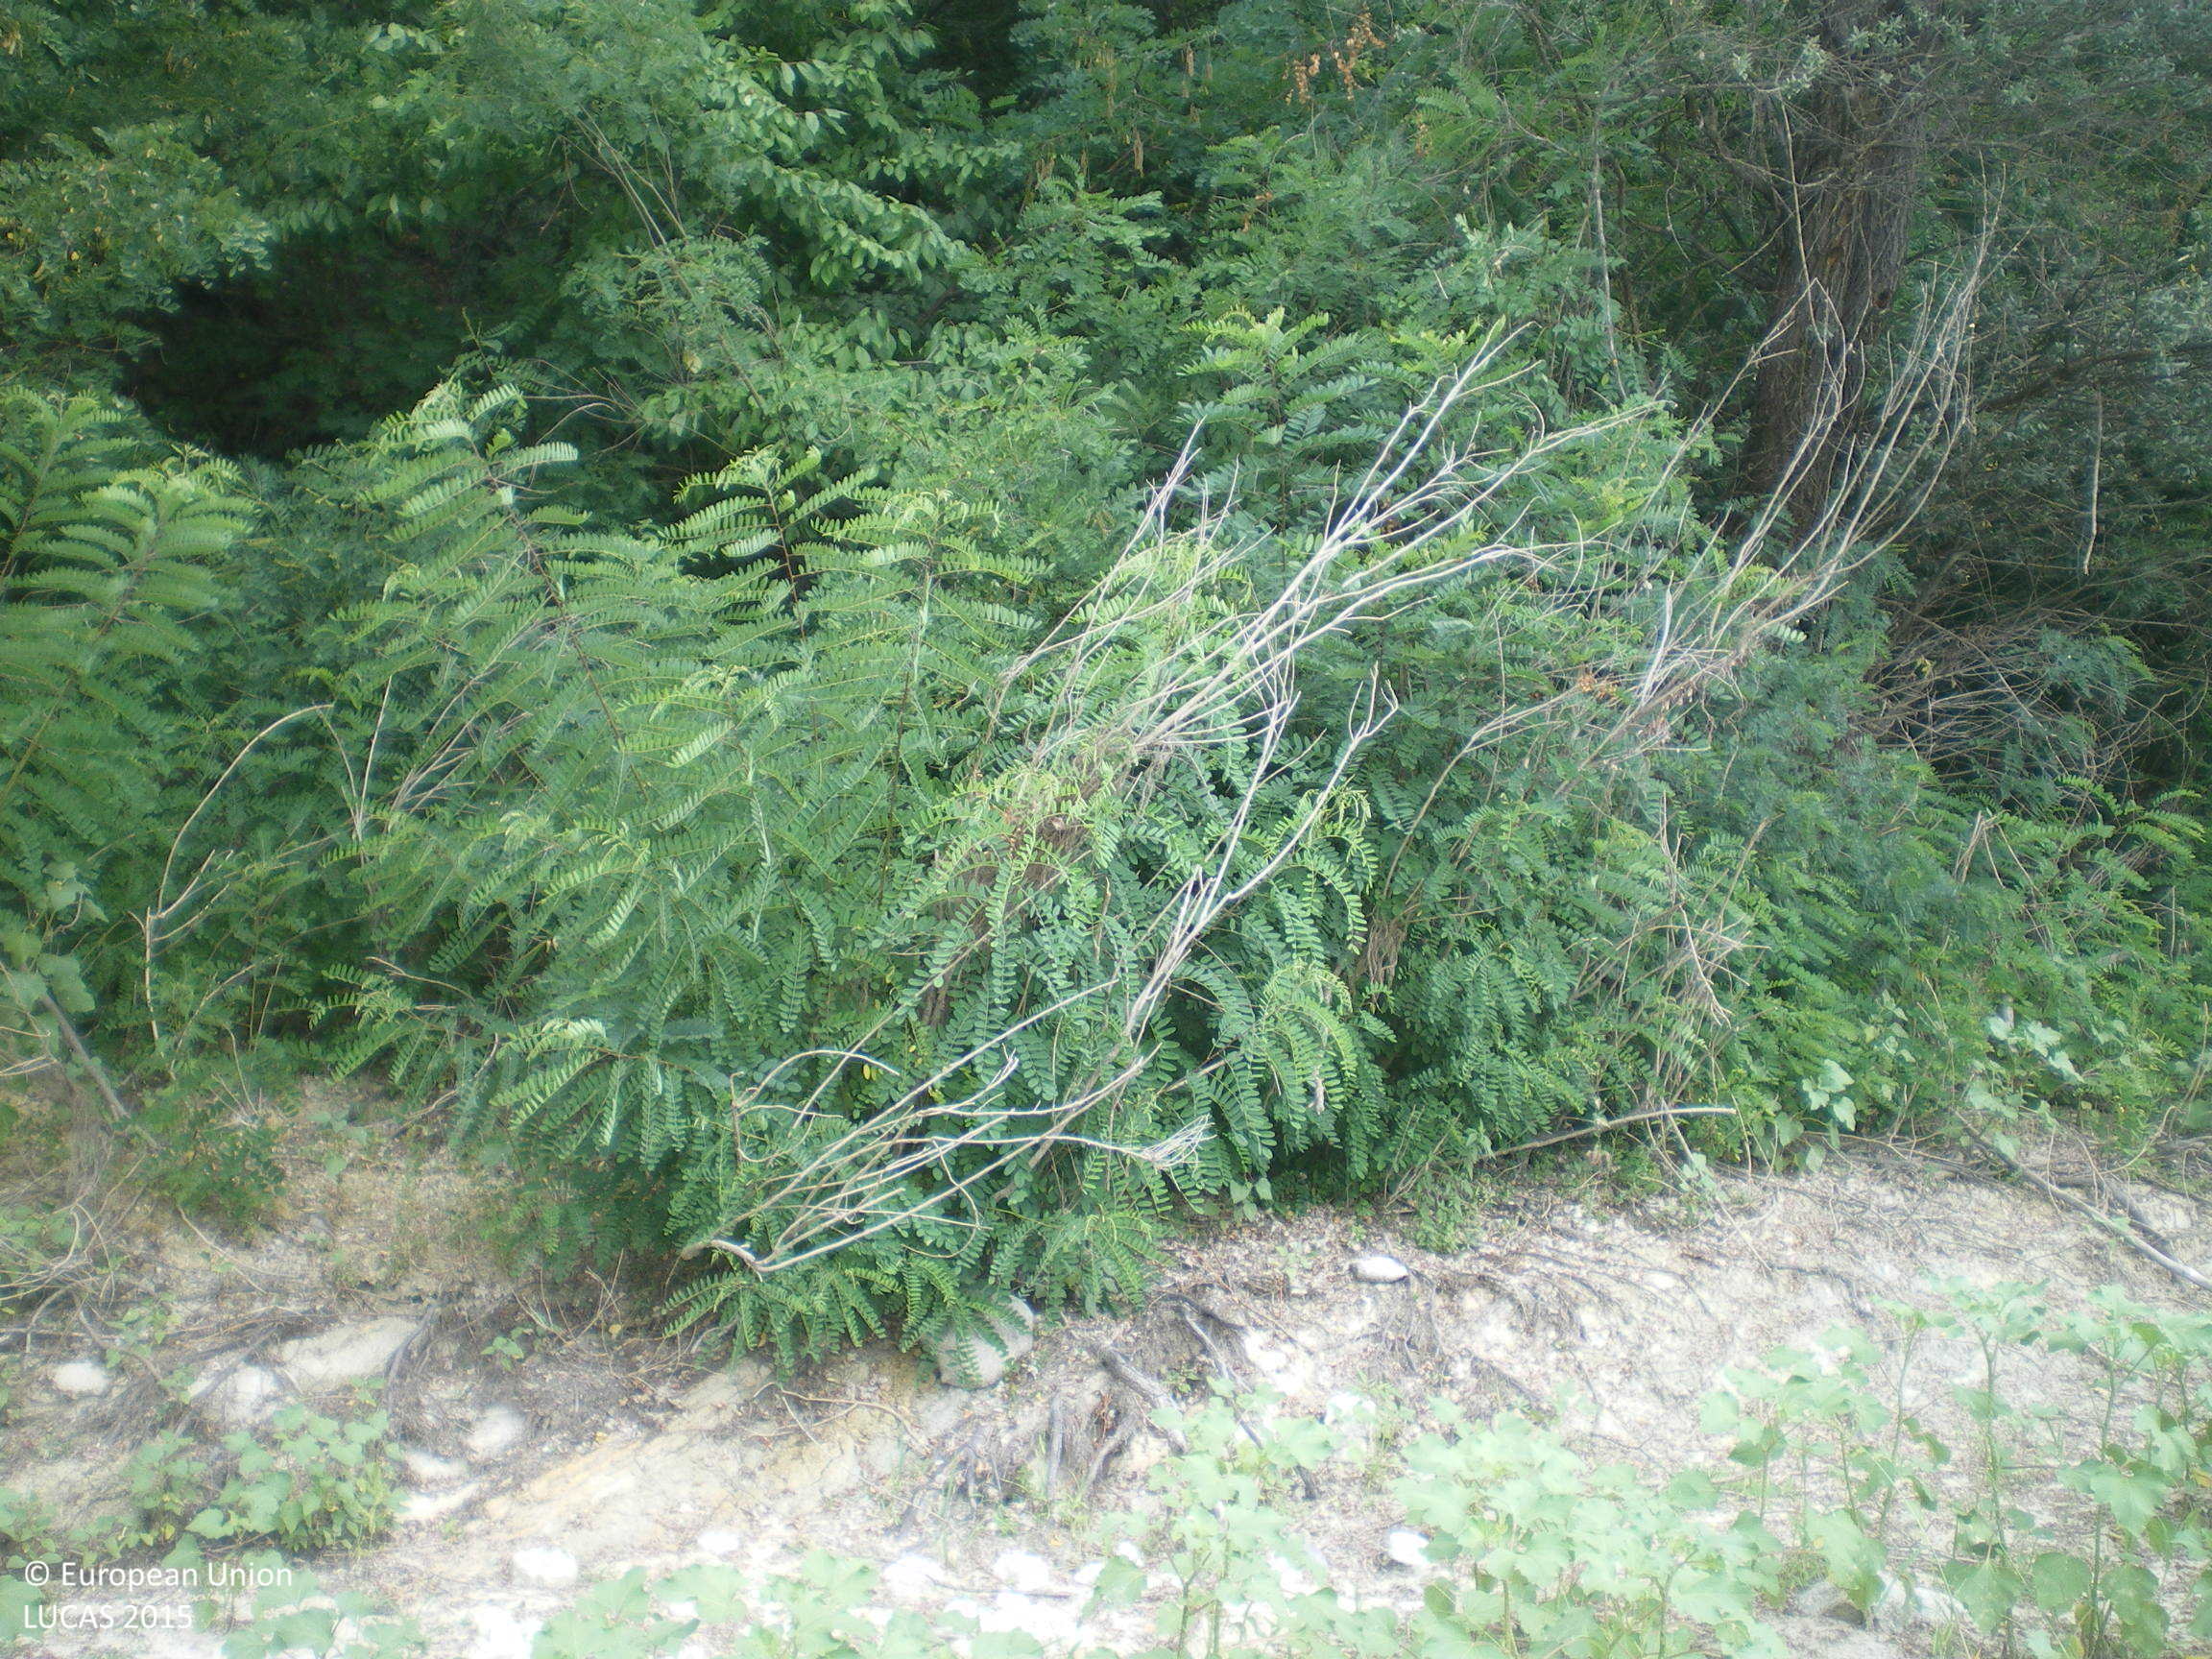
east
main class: Grassland
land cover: Spontaneously vegetated surfaces
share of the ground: > 75 %
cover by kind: herbaceous plants 60 %, unconsolidated bare surface 40 %
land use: Abandoned areas
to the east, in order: Spontaneously vegetated surfaces; Broadleaved woodland; Tracks; Shrubland with sparse tree cover; Broadleaved woodland; Pine dominated mixed woodland; Broadleaved woodland; Grassland with sparse tree/shrub cover; Shrubland with sparse tree cover
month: August
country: BG
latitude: 42.6218
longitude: 25.2955
